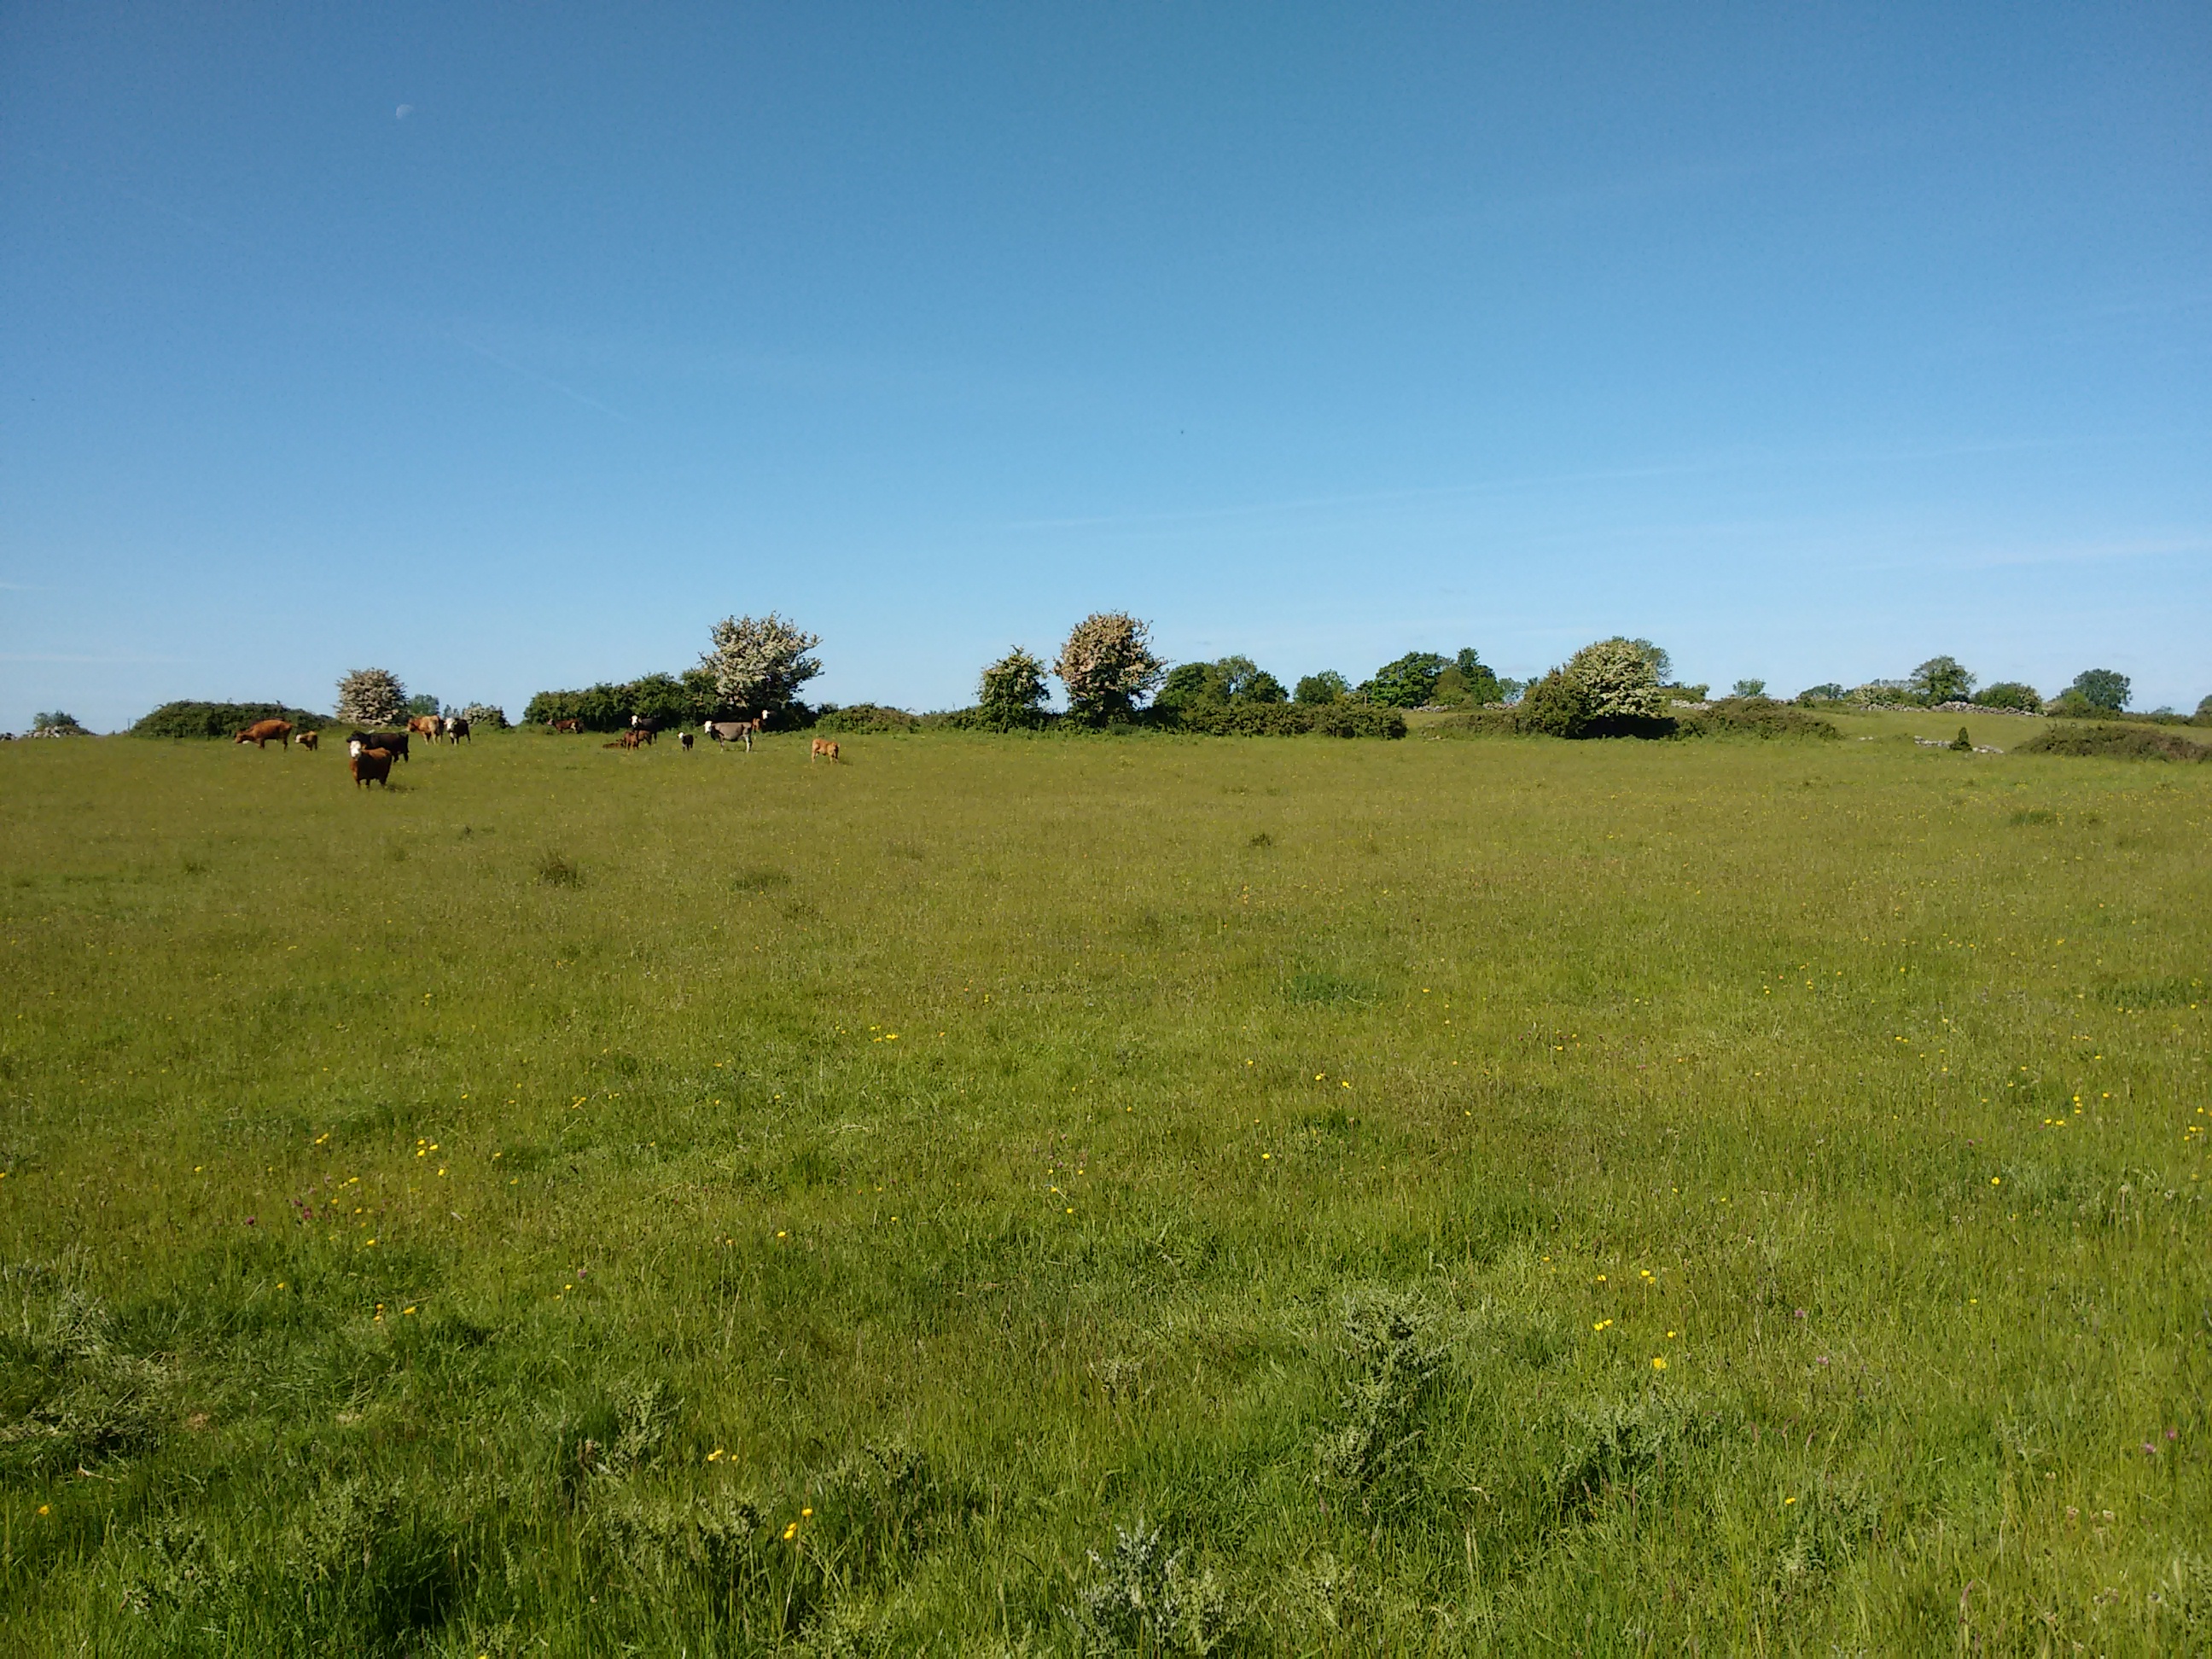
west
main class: Grassland
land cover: Grassland without tree/shrub cover
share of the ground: > 75 %
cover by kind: herbaceous plants 100 %
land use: Agriculture (excluding fallow land and kitchen gardens)
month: June
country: IE
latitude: 53.2167
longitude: -8.6026
